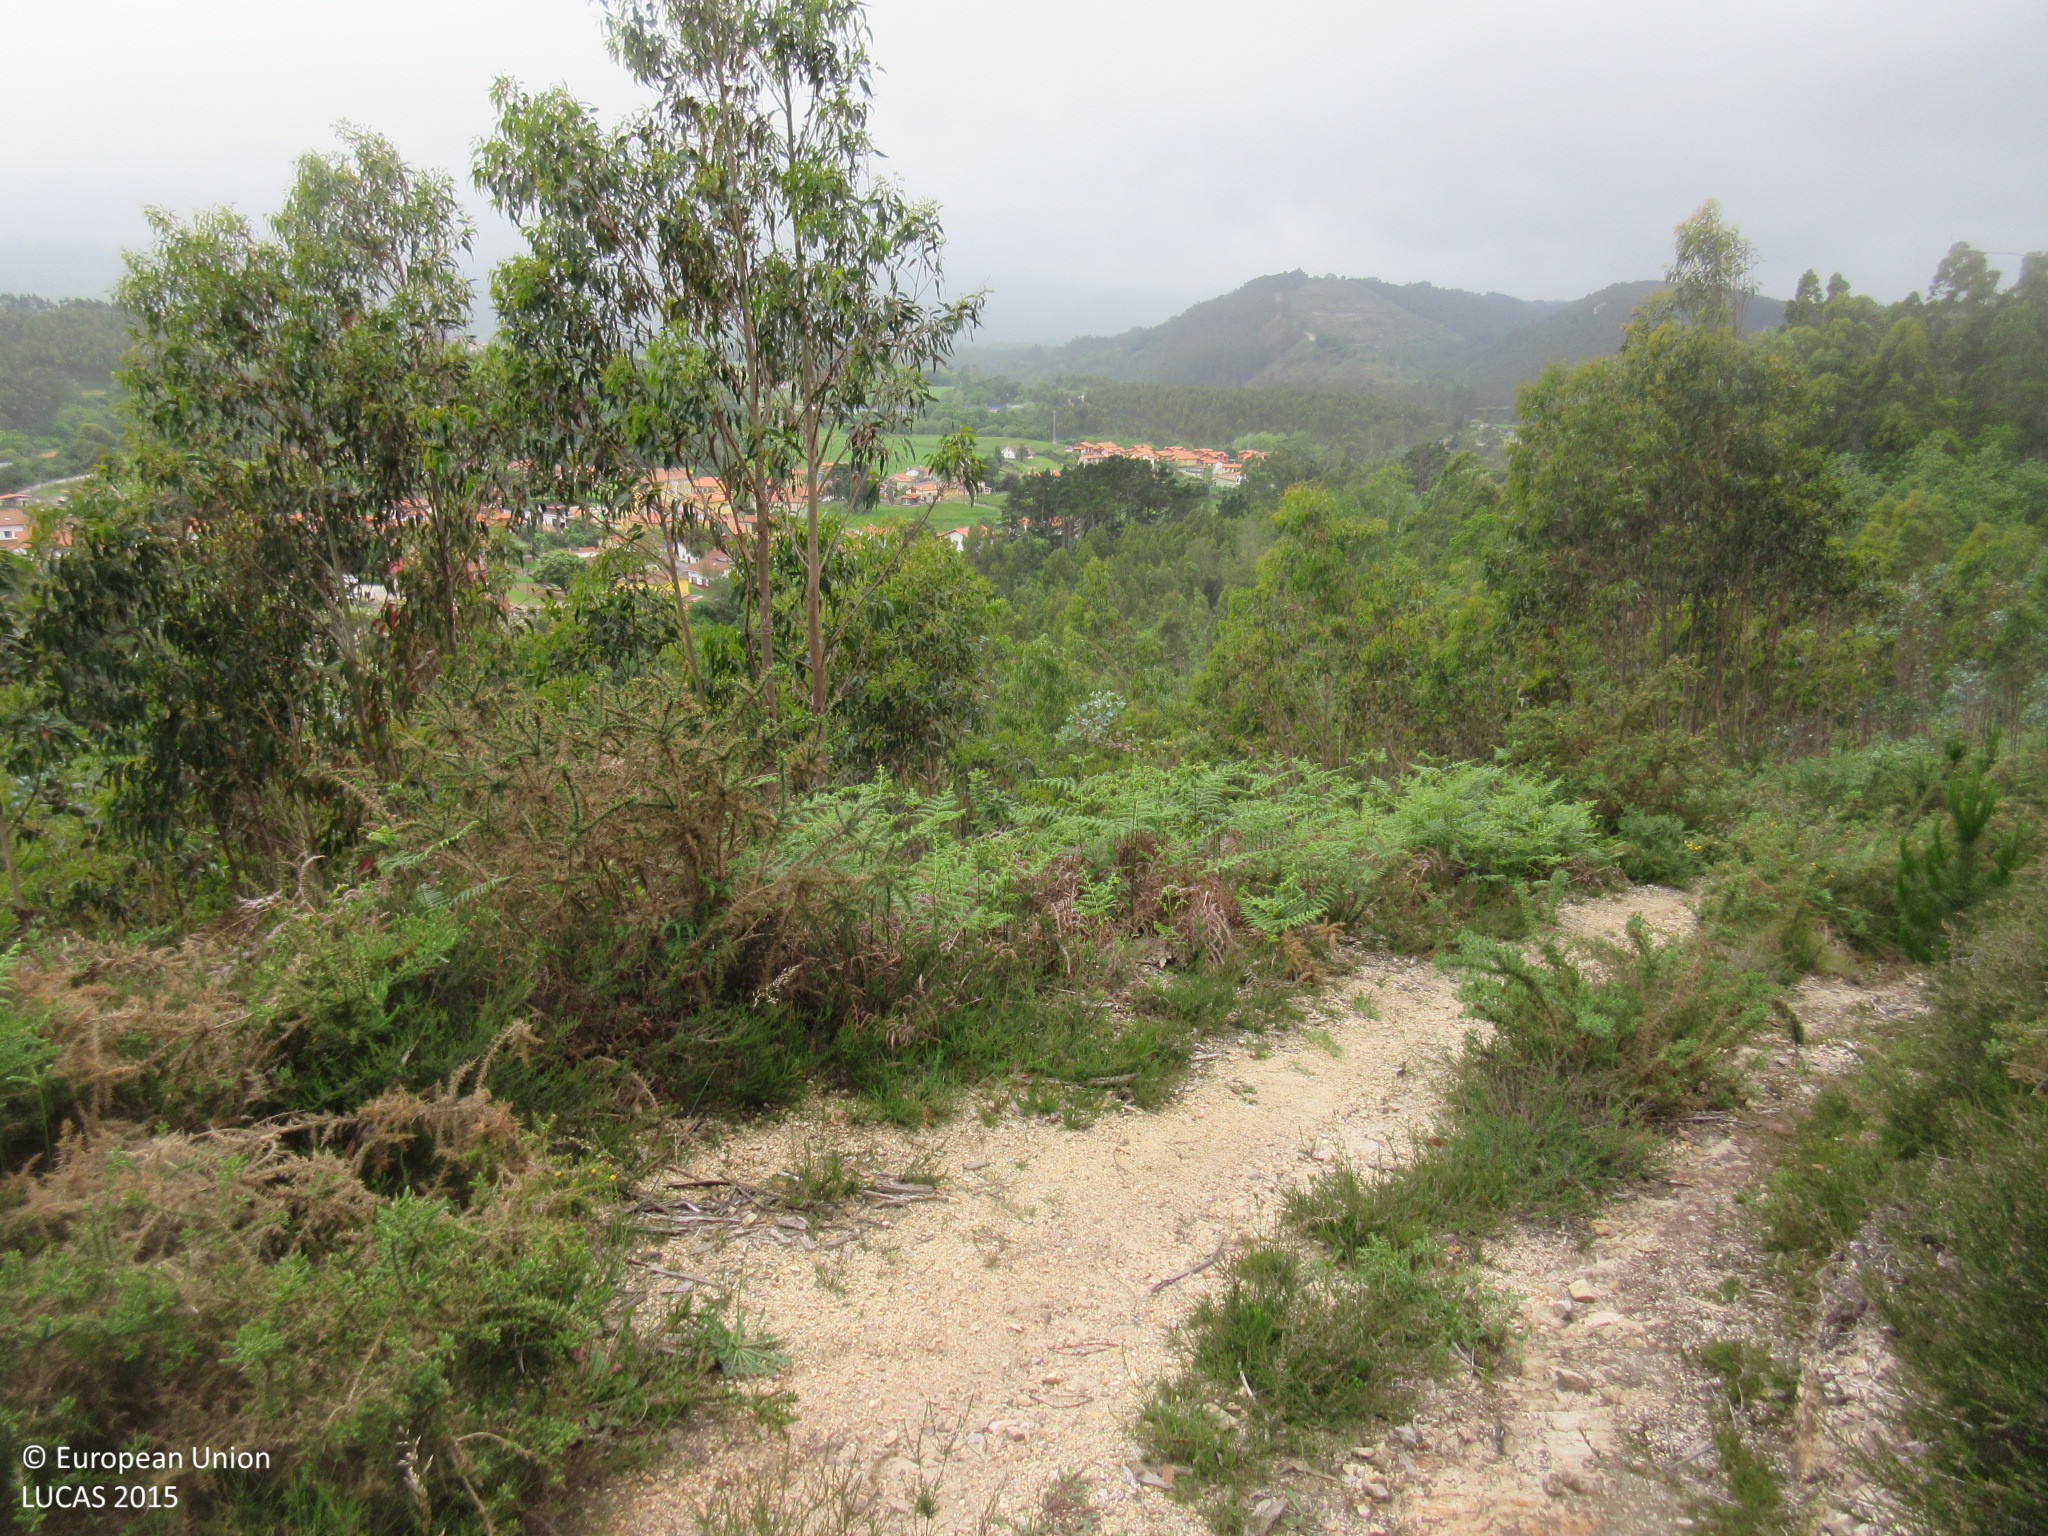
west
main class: Woodland
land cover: Broadleaved woodland
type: exotic forest
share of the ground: 50 - 75 %
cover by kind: broadleaved forest trees 60 %, shrubs 40 %
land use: Forestry
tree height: < 5 m
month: May
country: ES
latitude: 43.3894
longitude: -4.5671
